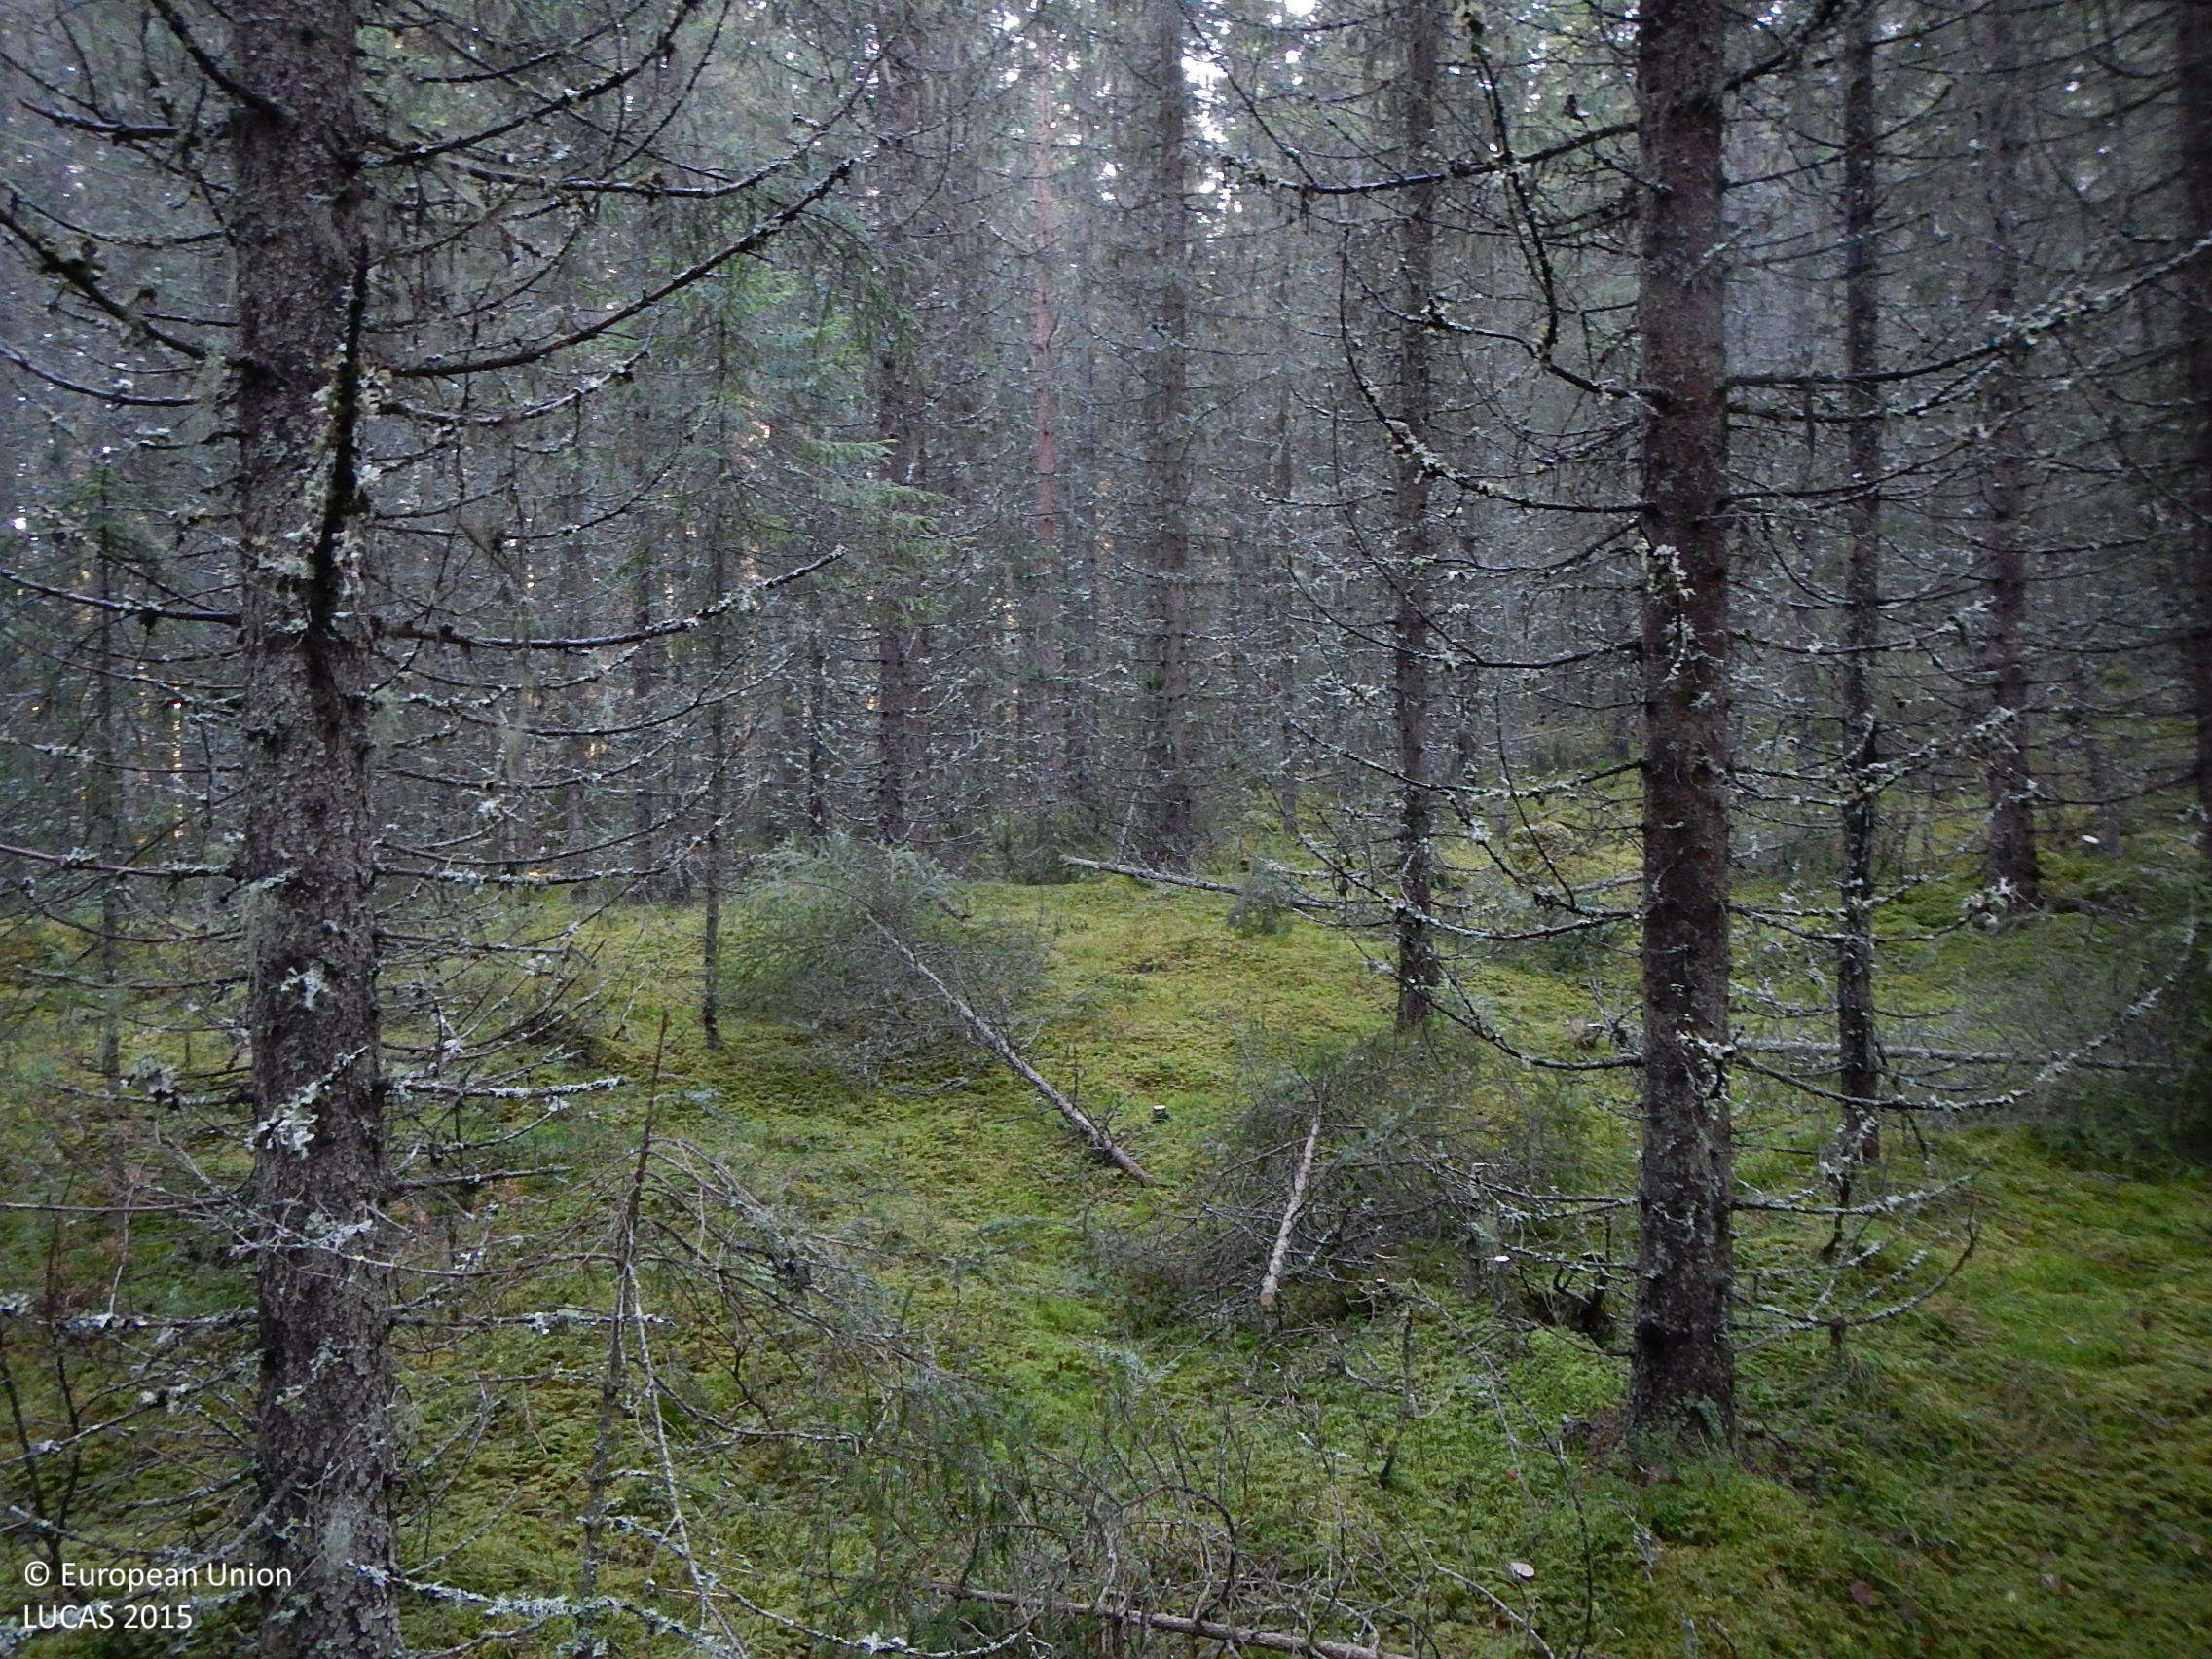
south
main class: Woodland
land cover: Spruce dominated coniferous woodland
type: boreal forest
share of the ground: > 75 %
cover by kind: coniferous forest trees 90 %, lichens and mosses 10 %
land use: Forestry
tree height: > 5 m
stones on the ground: < 10 %
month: November
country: SE
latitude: 61.5155
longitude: 15.5663
